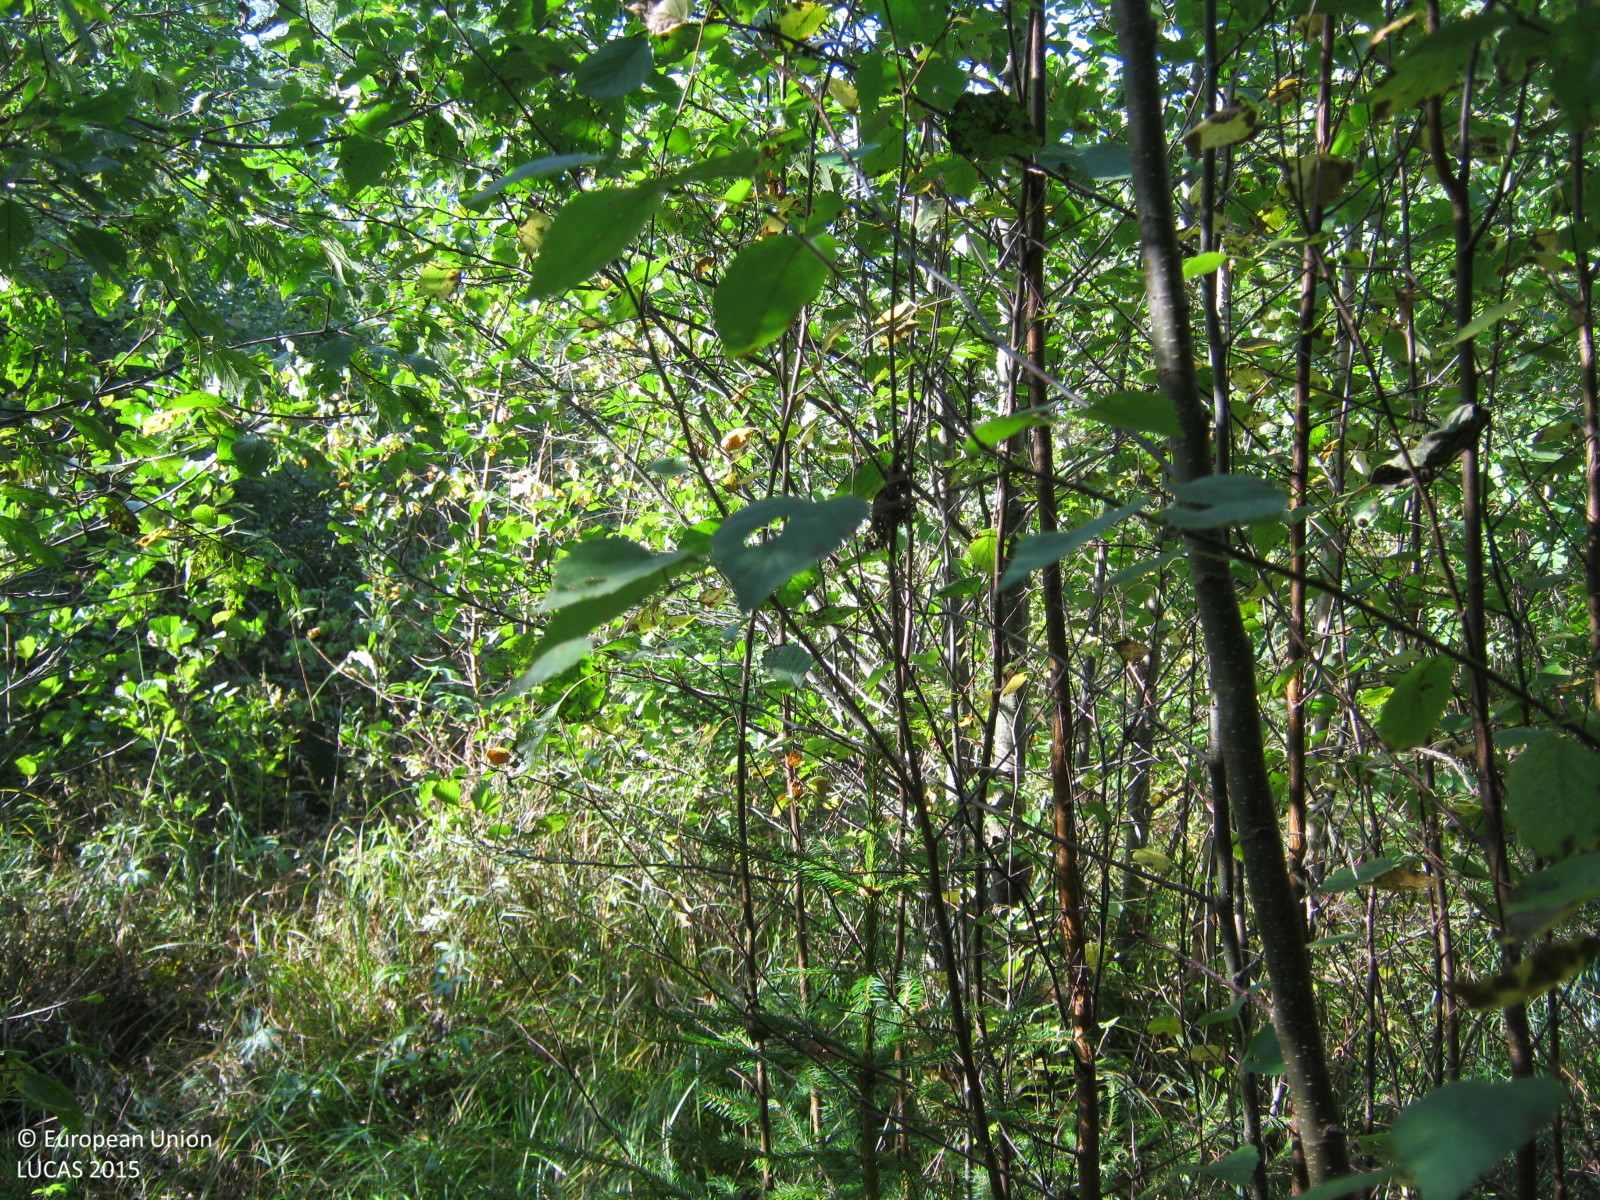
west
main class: Woodland
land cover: Broadleaved woodland
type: non-riverine alder, birch or aspen forest
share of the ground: > 75 %
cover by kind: broadleaved forest trees 90 %, herbaceous plants 10 %
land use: Forestry
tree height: > 5 m
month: September
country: LV
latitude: 57.4062
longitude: 24.5229
